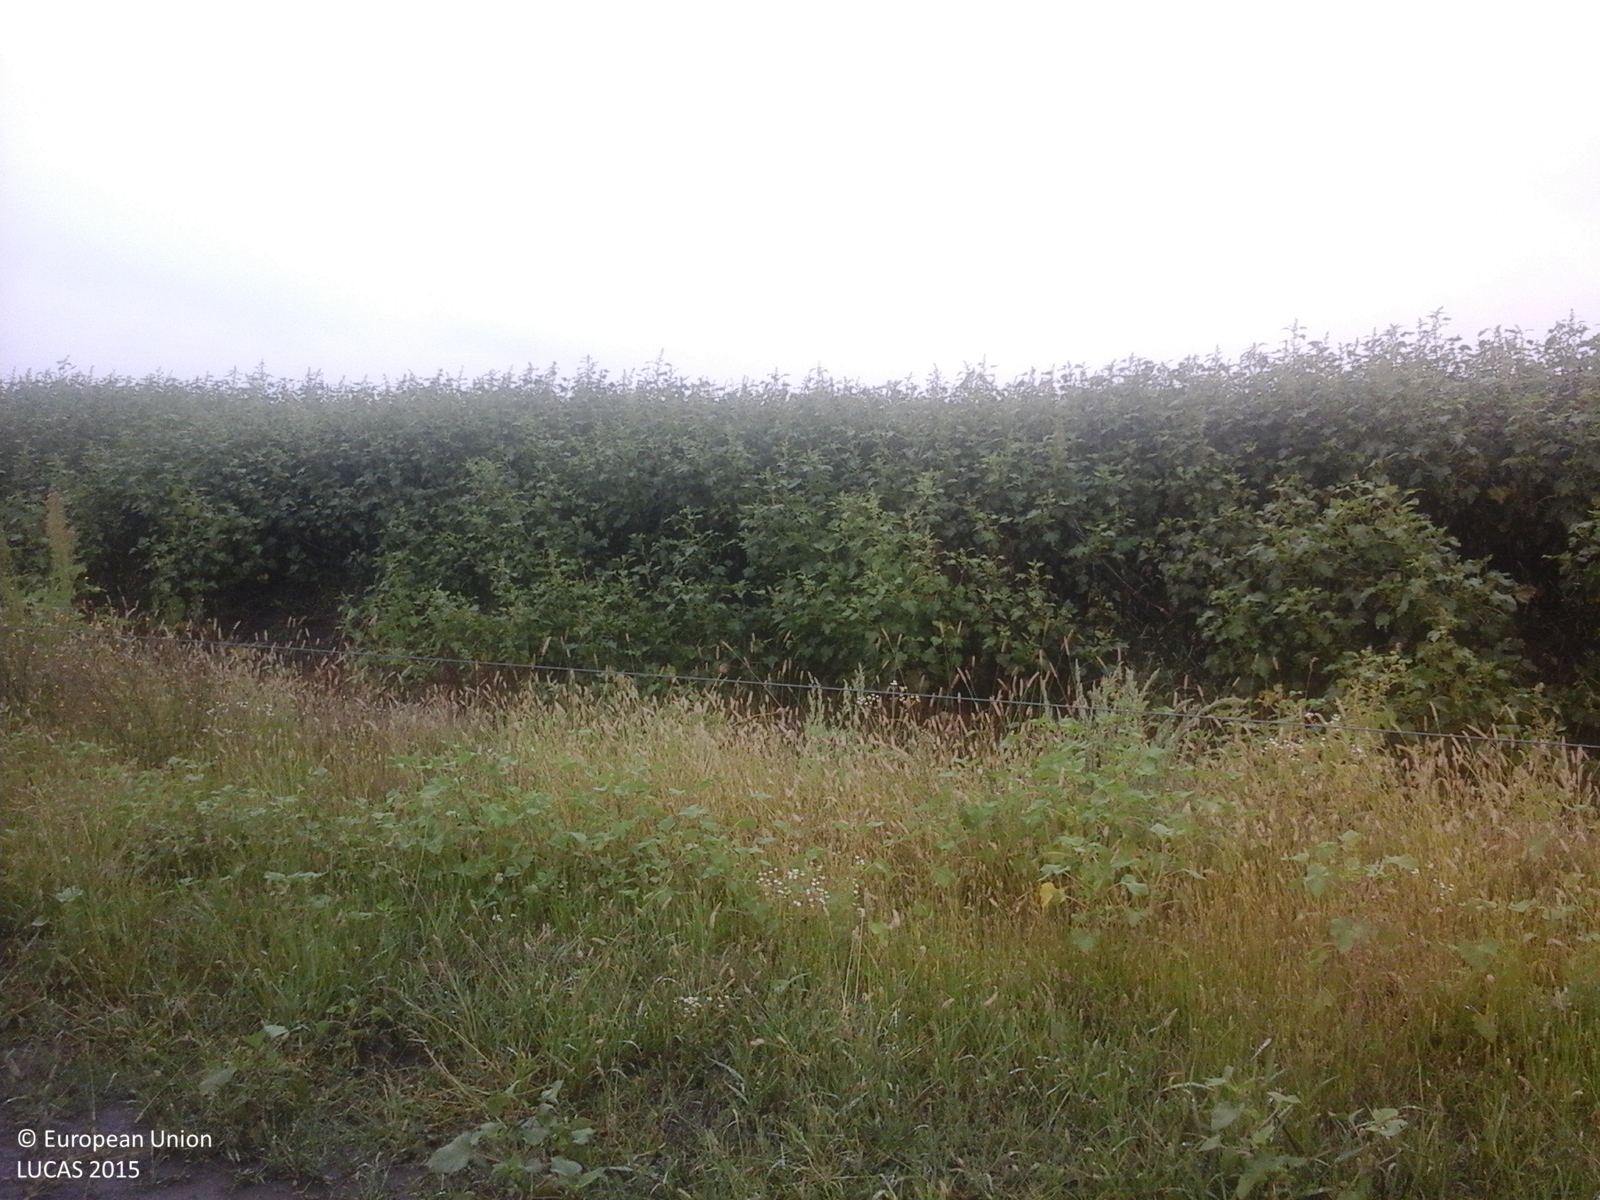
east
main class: Cropland
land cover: Sunflower
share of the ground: > 75 %
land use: Agriculture (excluding fallow land and kitchen gardens)
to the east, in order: Sunflower
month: August
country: RO
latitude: 45.9968
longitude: 20.4954
